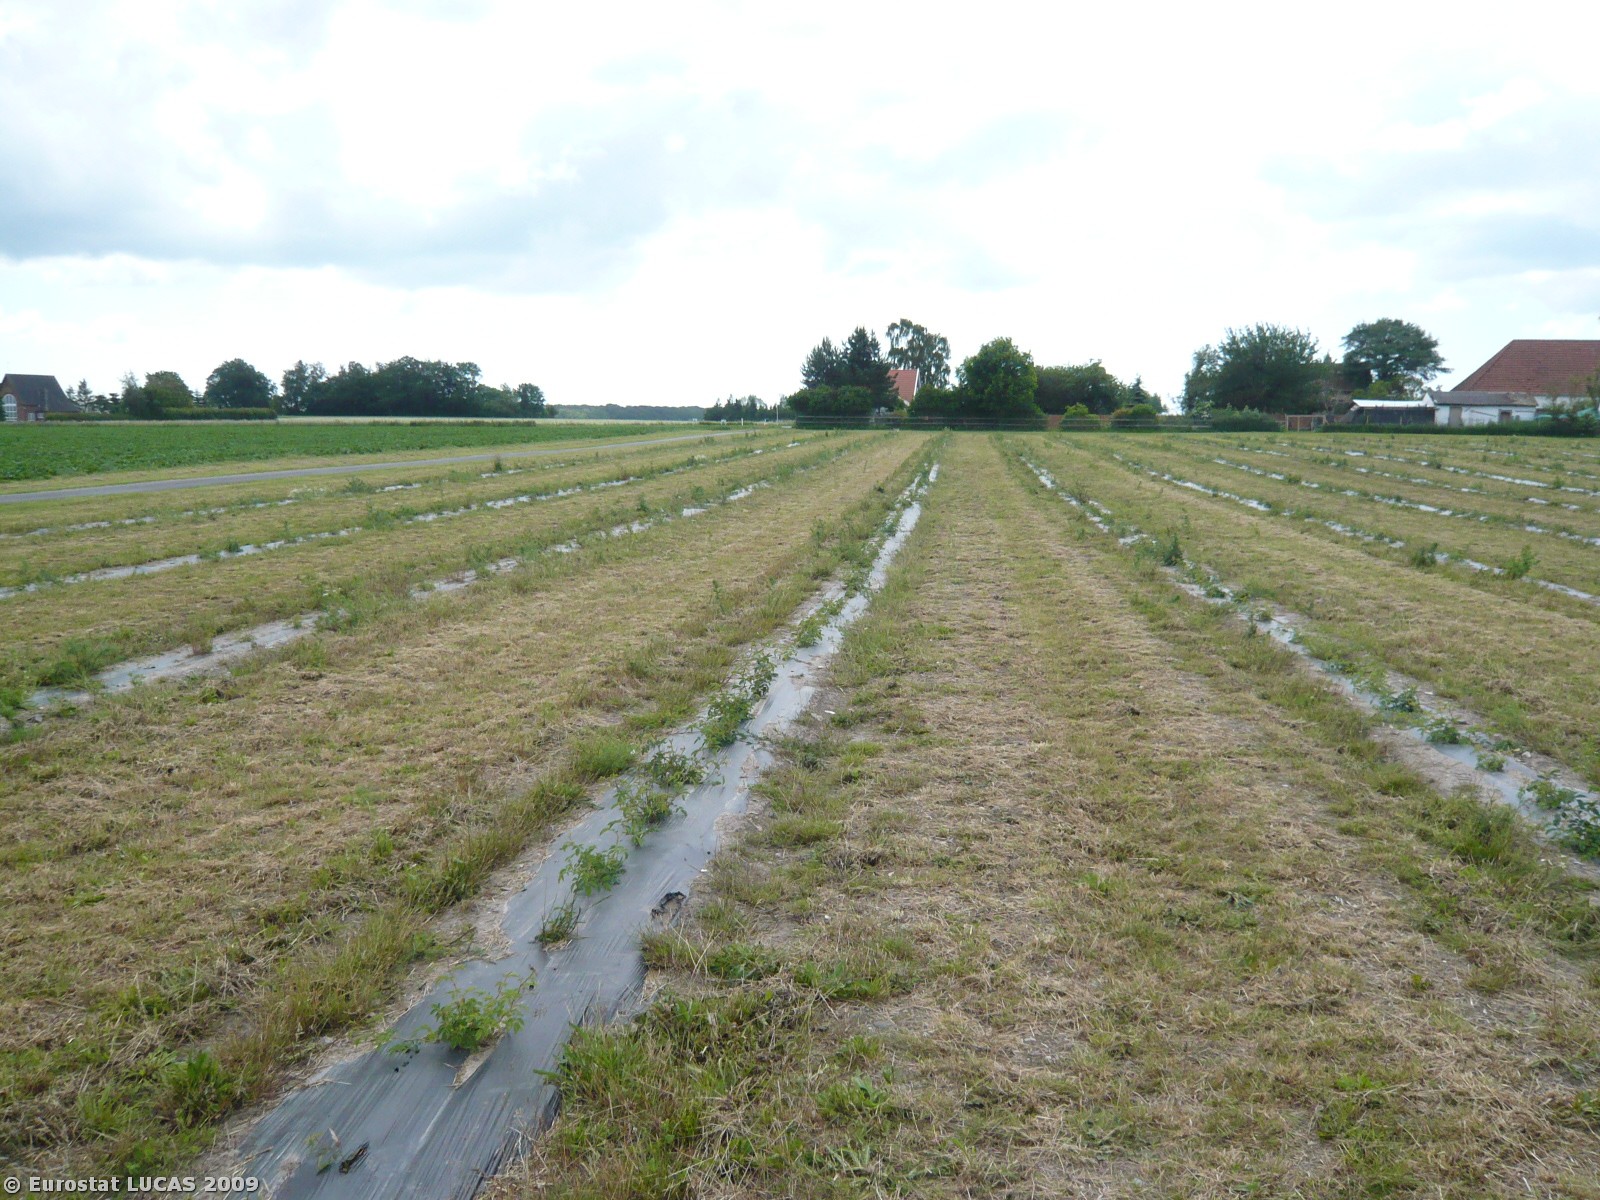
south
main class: Cropland
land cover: Common wheat
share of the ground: 10 - 25 %
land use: Agriculture (excluding fallow land and kitchen gardens)
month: June
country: DK
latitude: 54.7572
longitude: 11.6305
